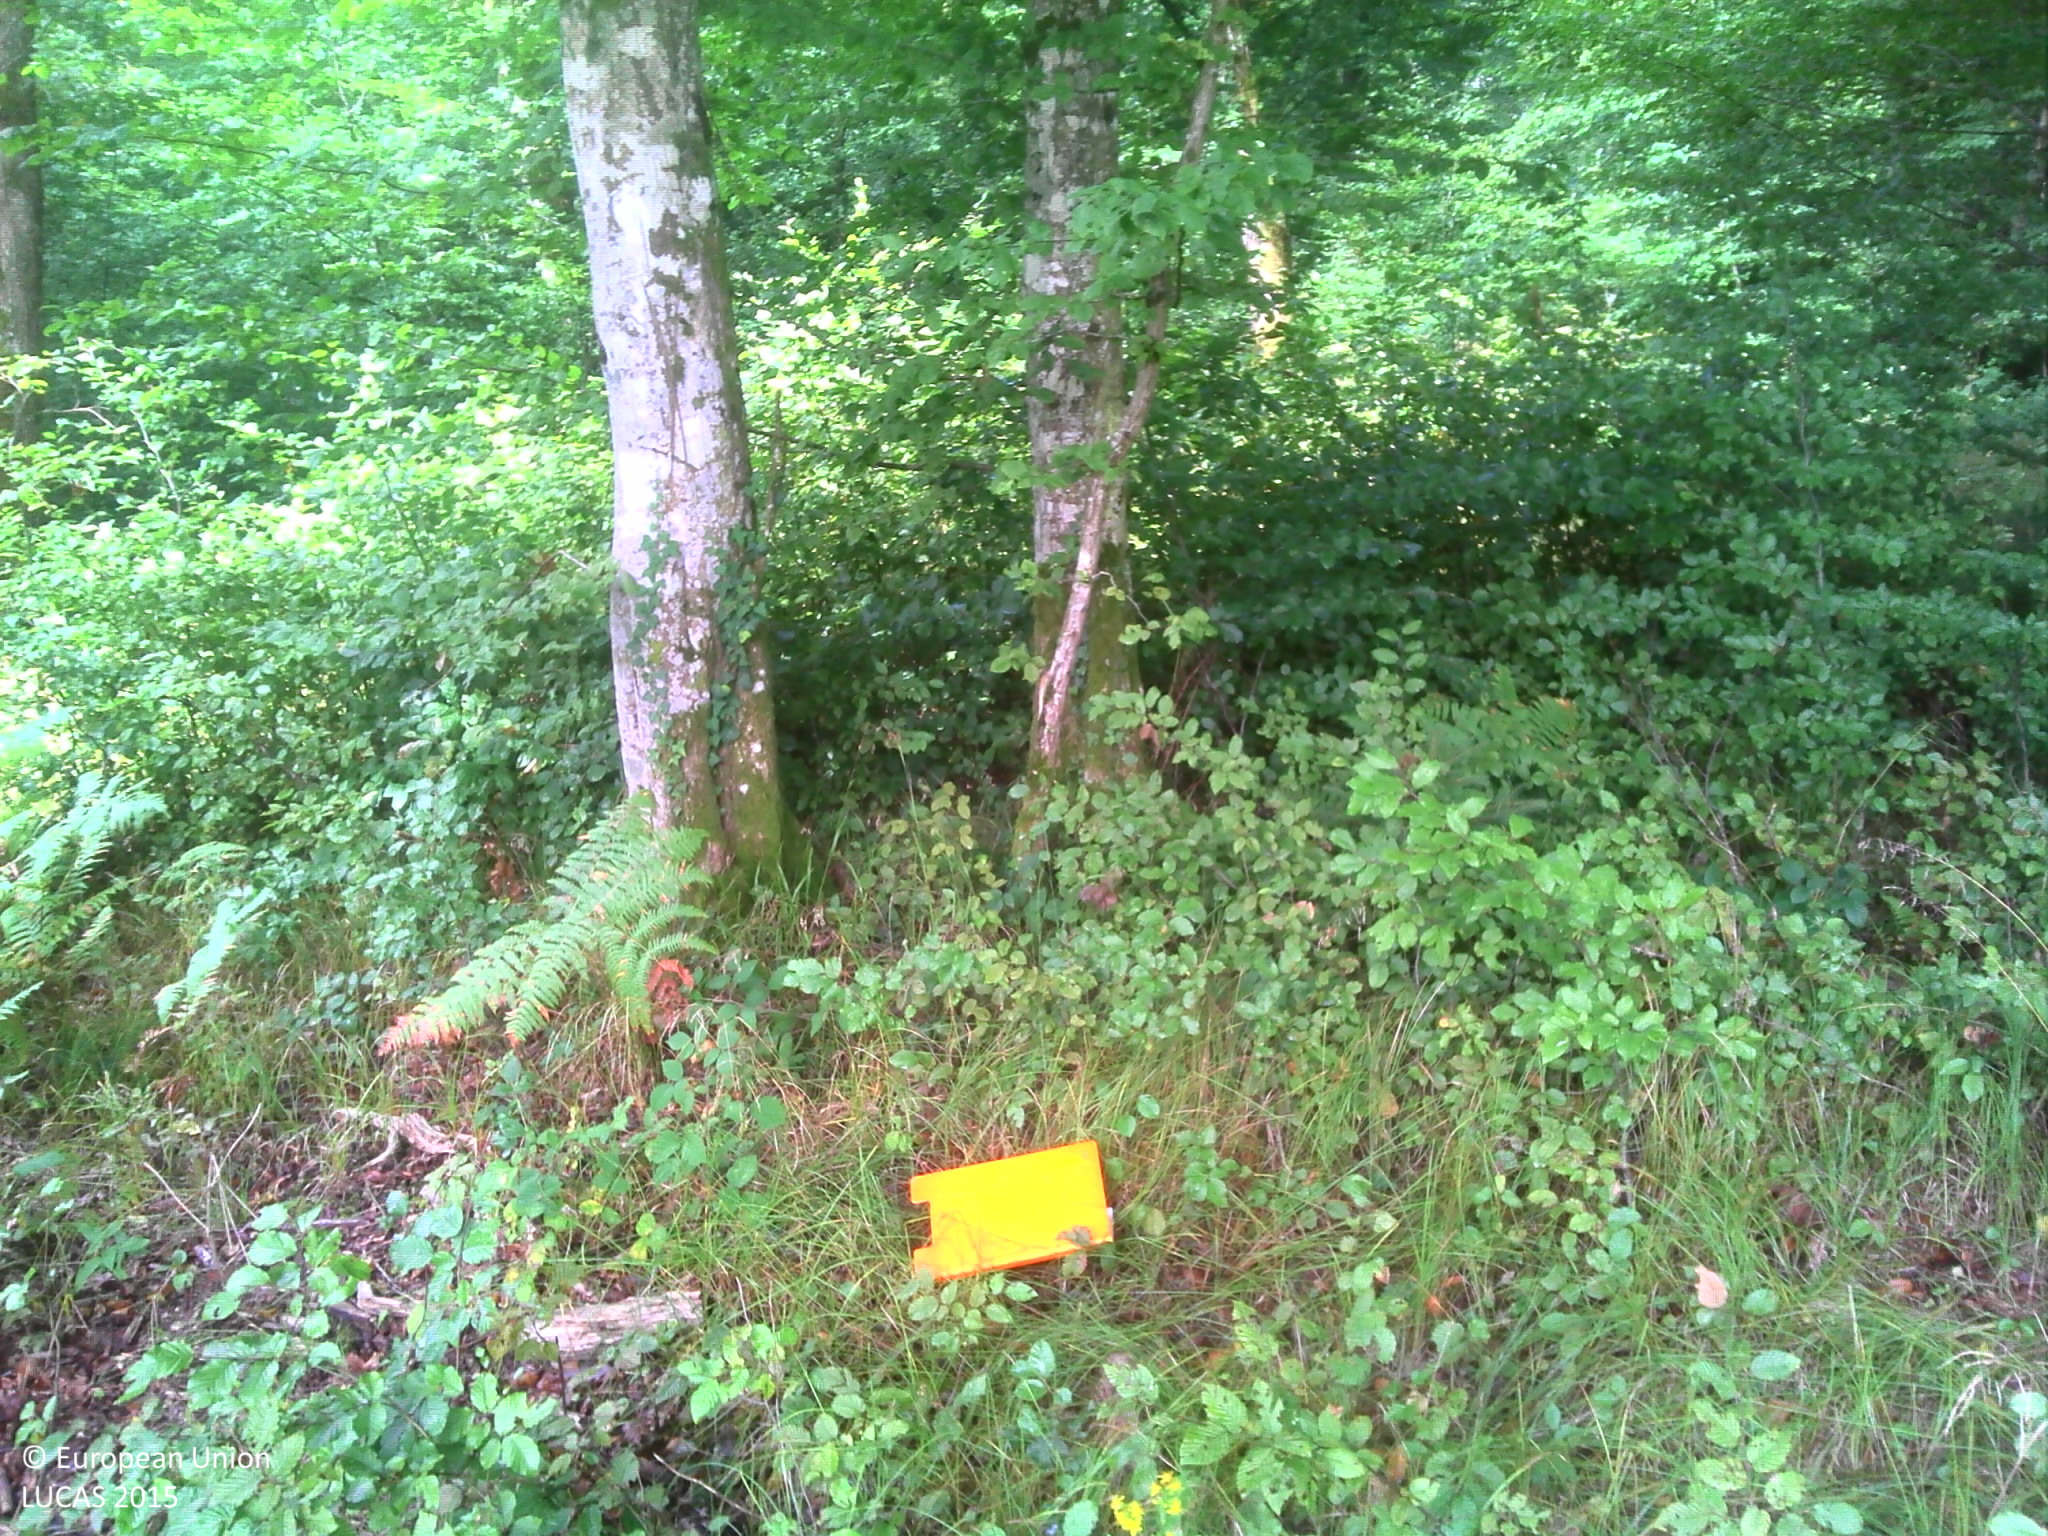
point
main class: Woodland
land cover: Broadleaved woodland
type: mesophytic deciduous forest
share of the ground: > 75 %
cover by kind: broadleaved forest trees 90 %, herbaceous plants 10 %
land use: Forestry
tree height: > 5 m
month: September
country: FR
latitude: 47.4951
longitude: 6.8823
